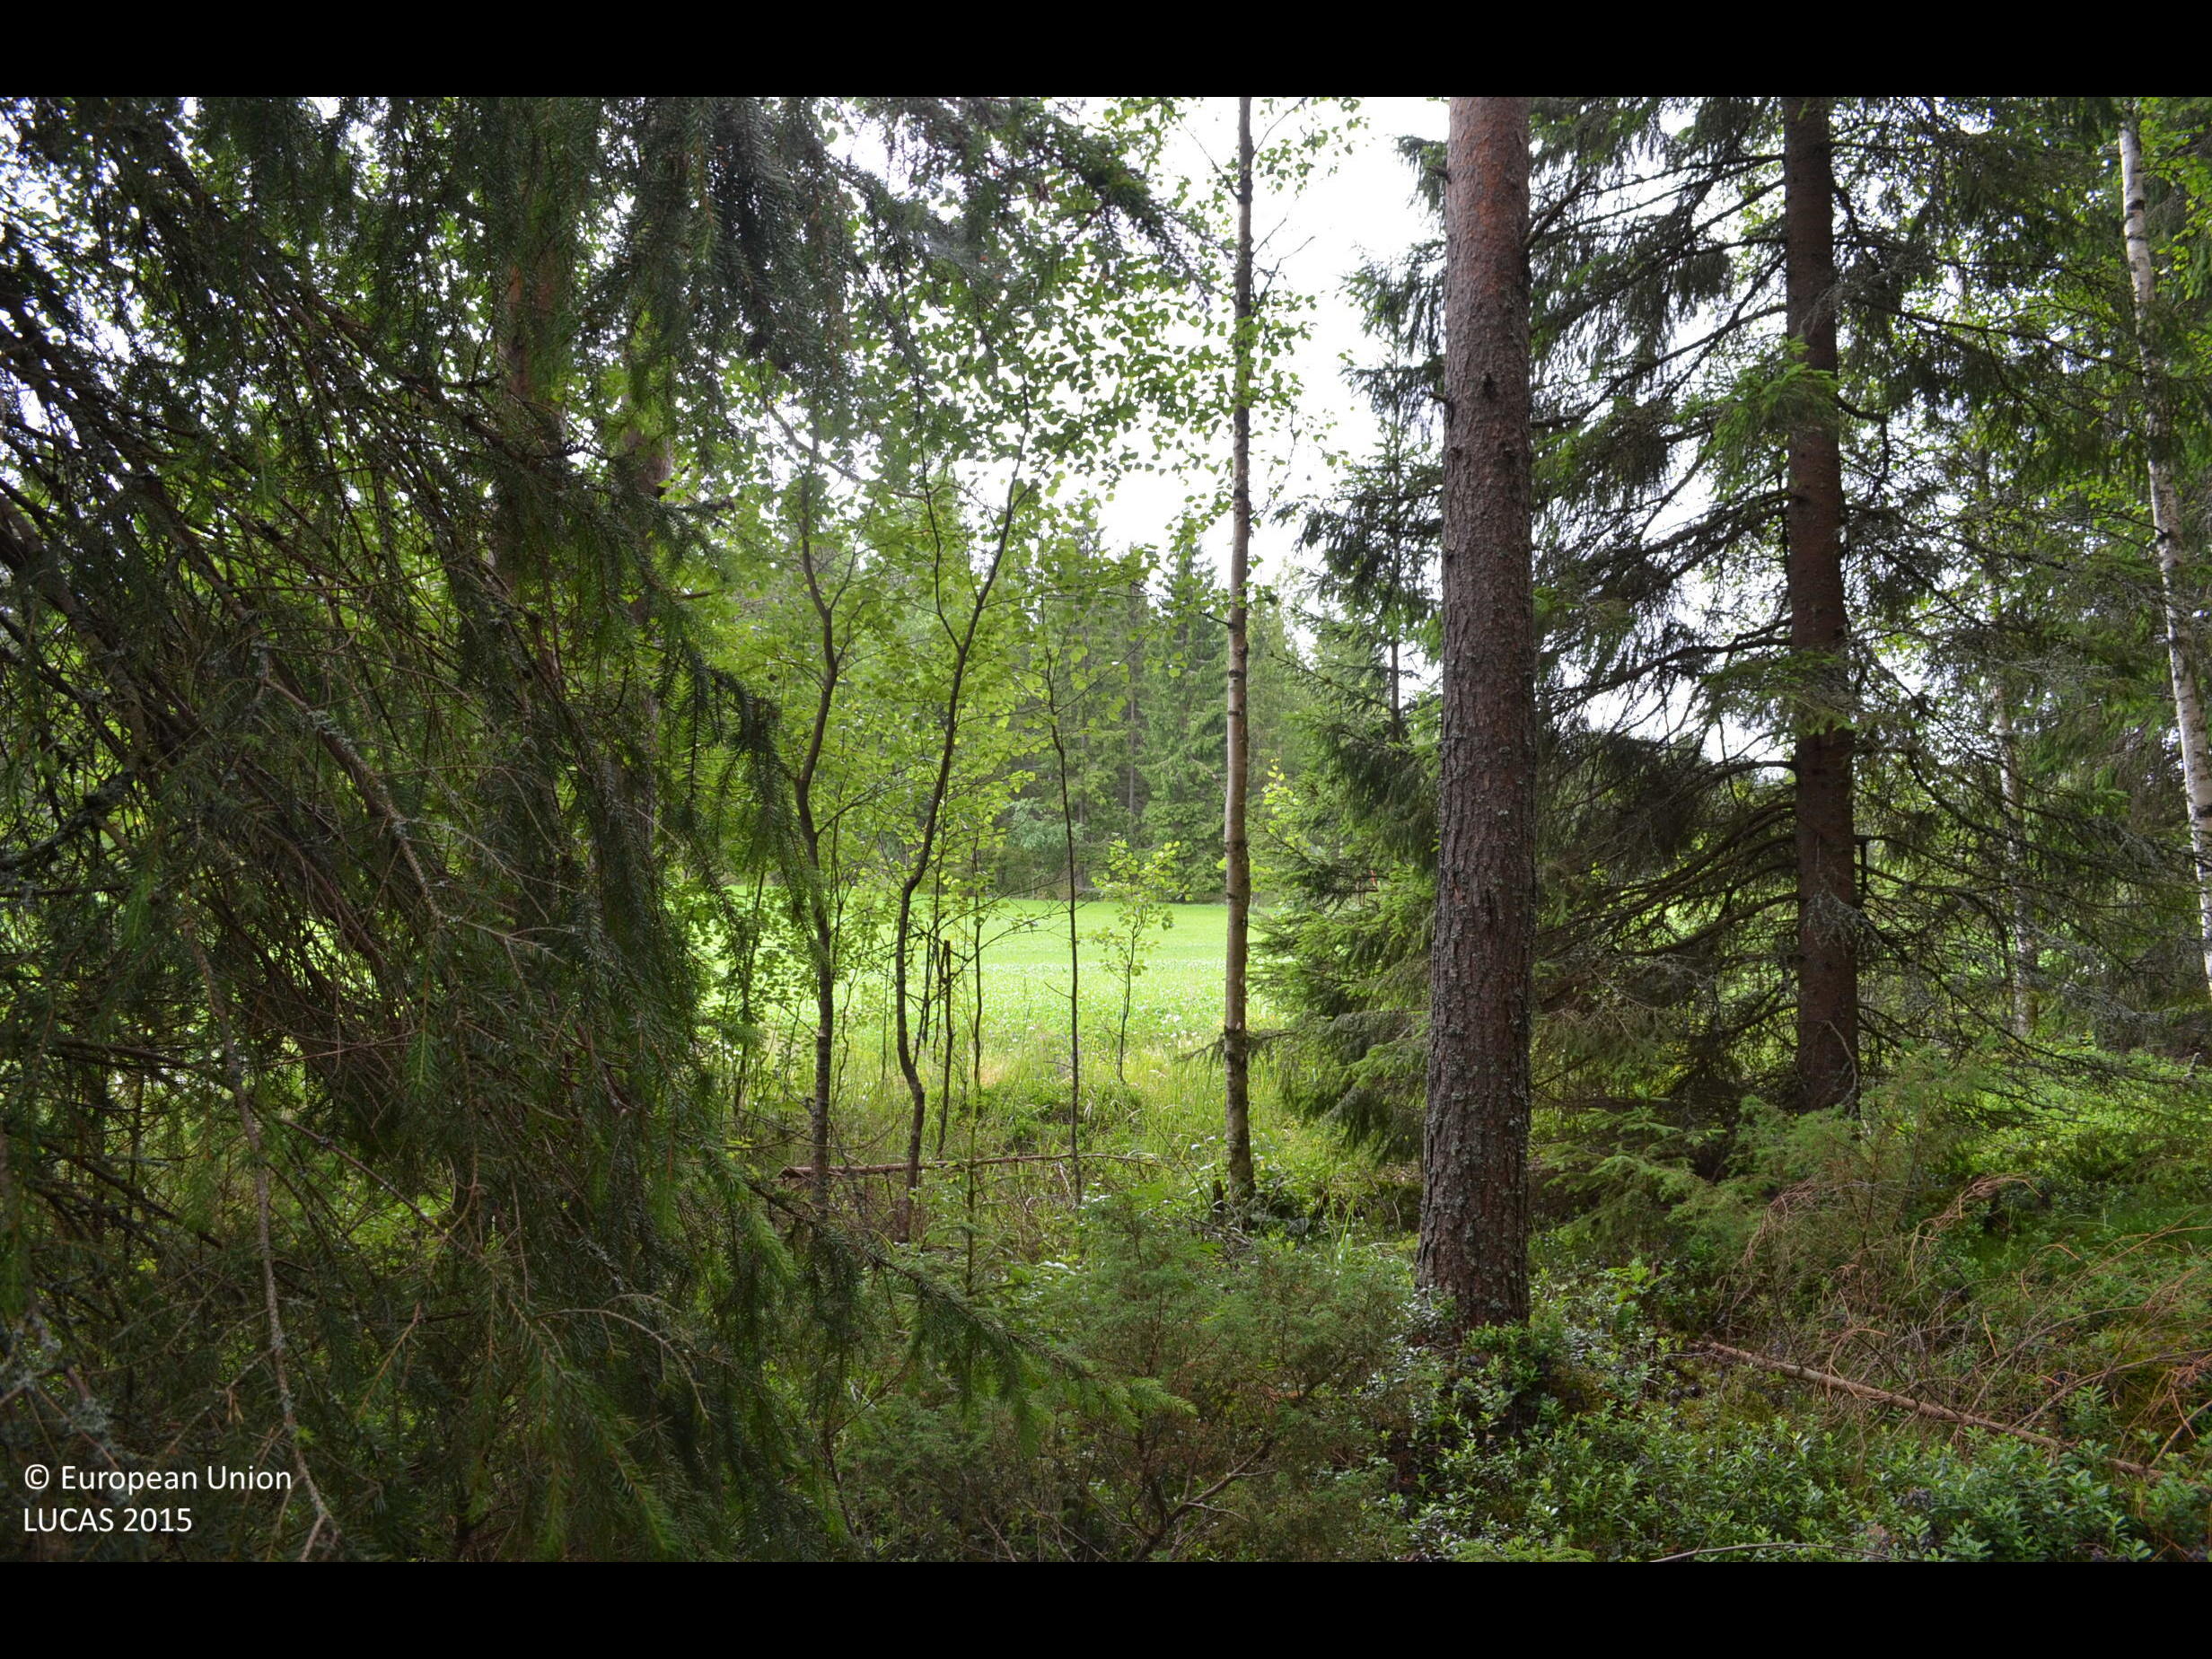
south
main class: Woodland
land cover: Pine dominated coniferous woodland
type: boreal forest
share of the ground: > 75 %
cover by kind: coniferous forest trees 80 %, broadleaved forest trees 10 %, shrubs 10 %
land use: Forestry
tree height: > 5 m
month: July
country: FI
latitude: 62.2863
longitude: 23.5861
